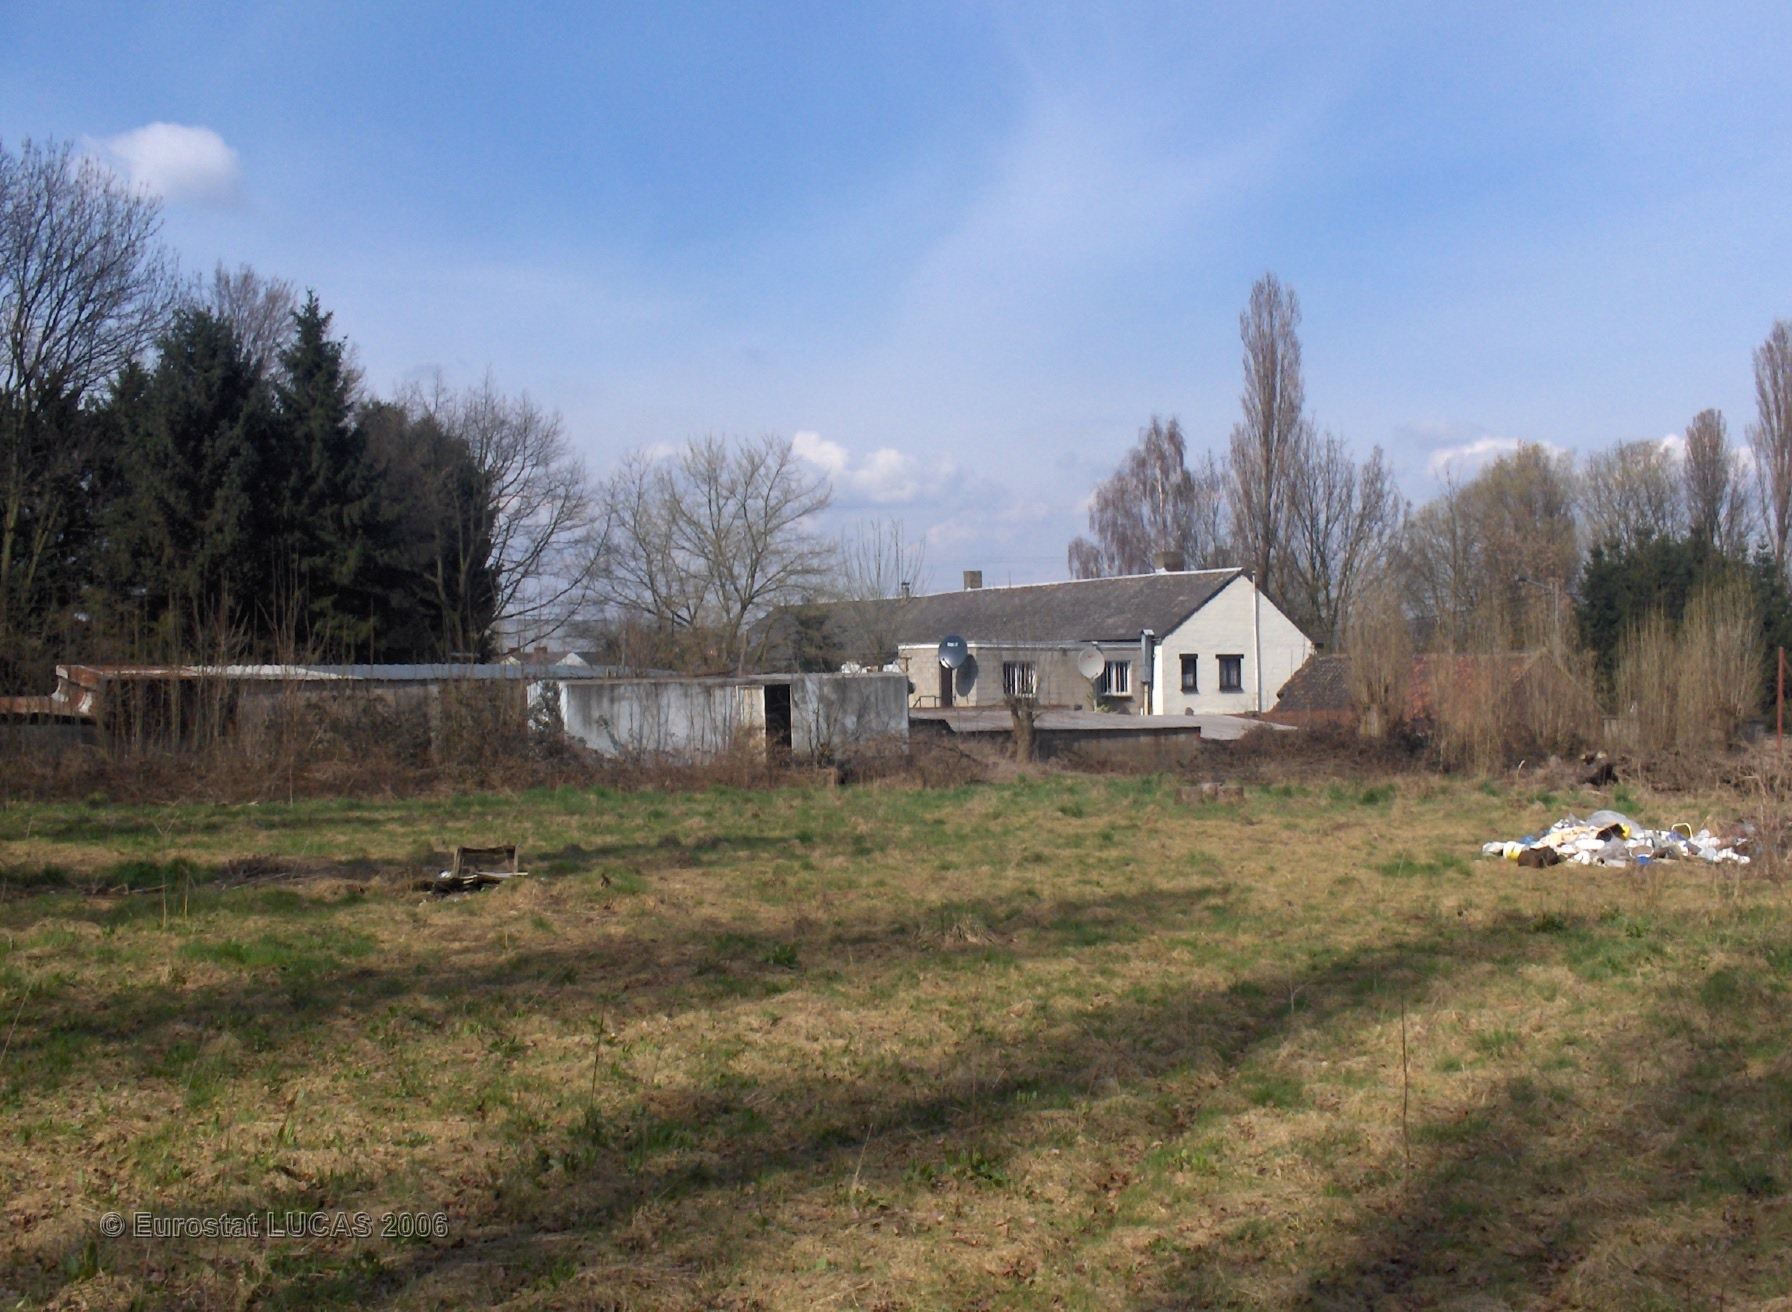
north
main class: Grassland
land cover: Grassland with sparse tree/shrub cover
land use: Agriculture (excluding fallow land and kitchen gardens)
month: April
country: BE
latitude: 50.4144
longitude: 4.5498
